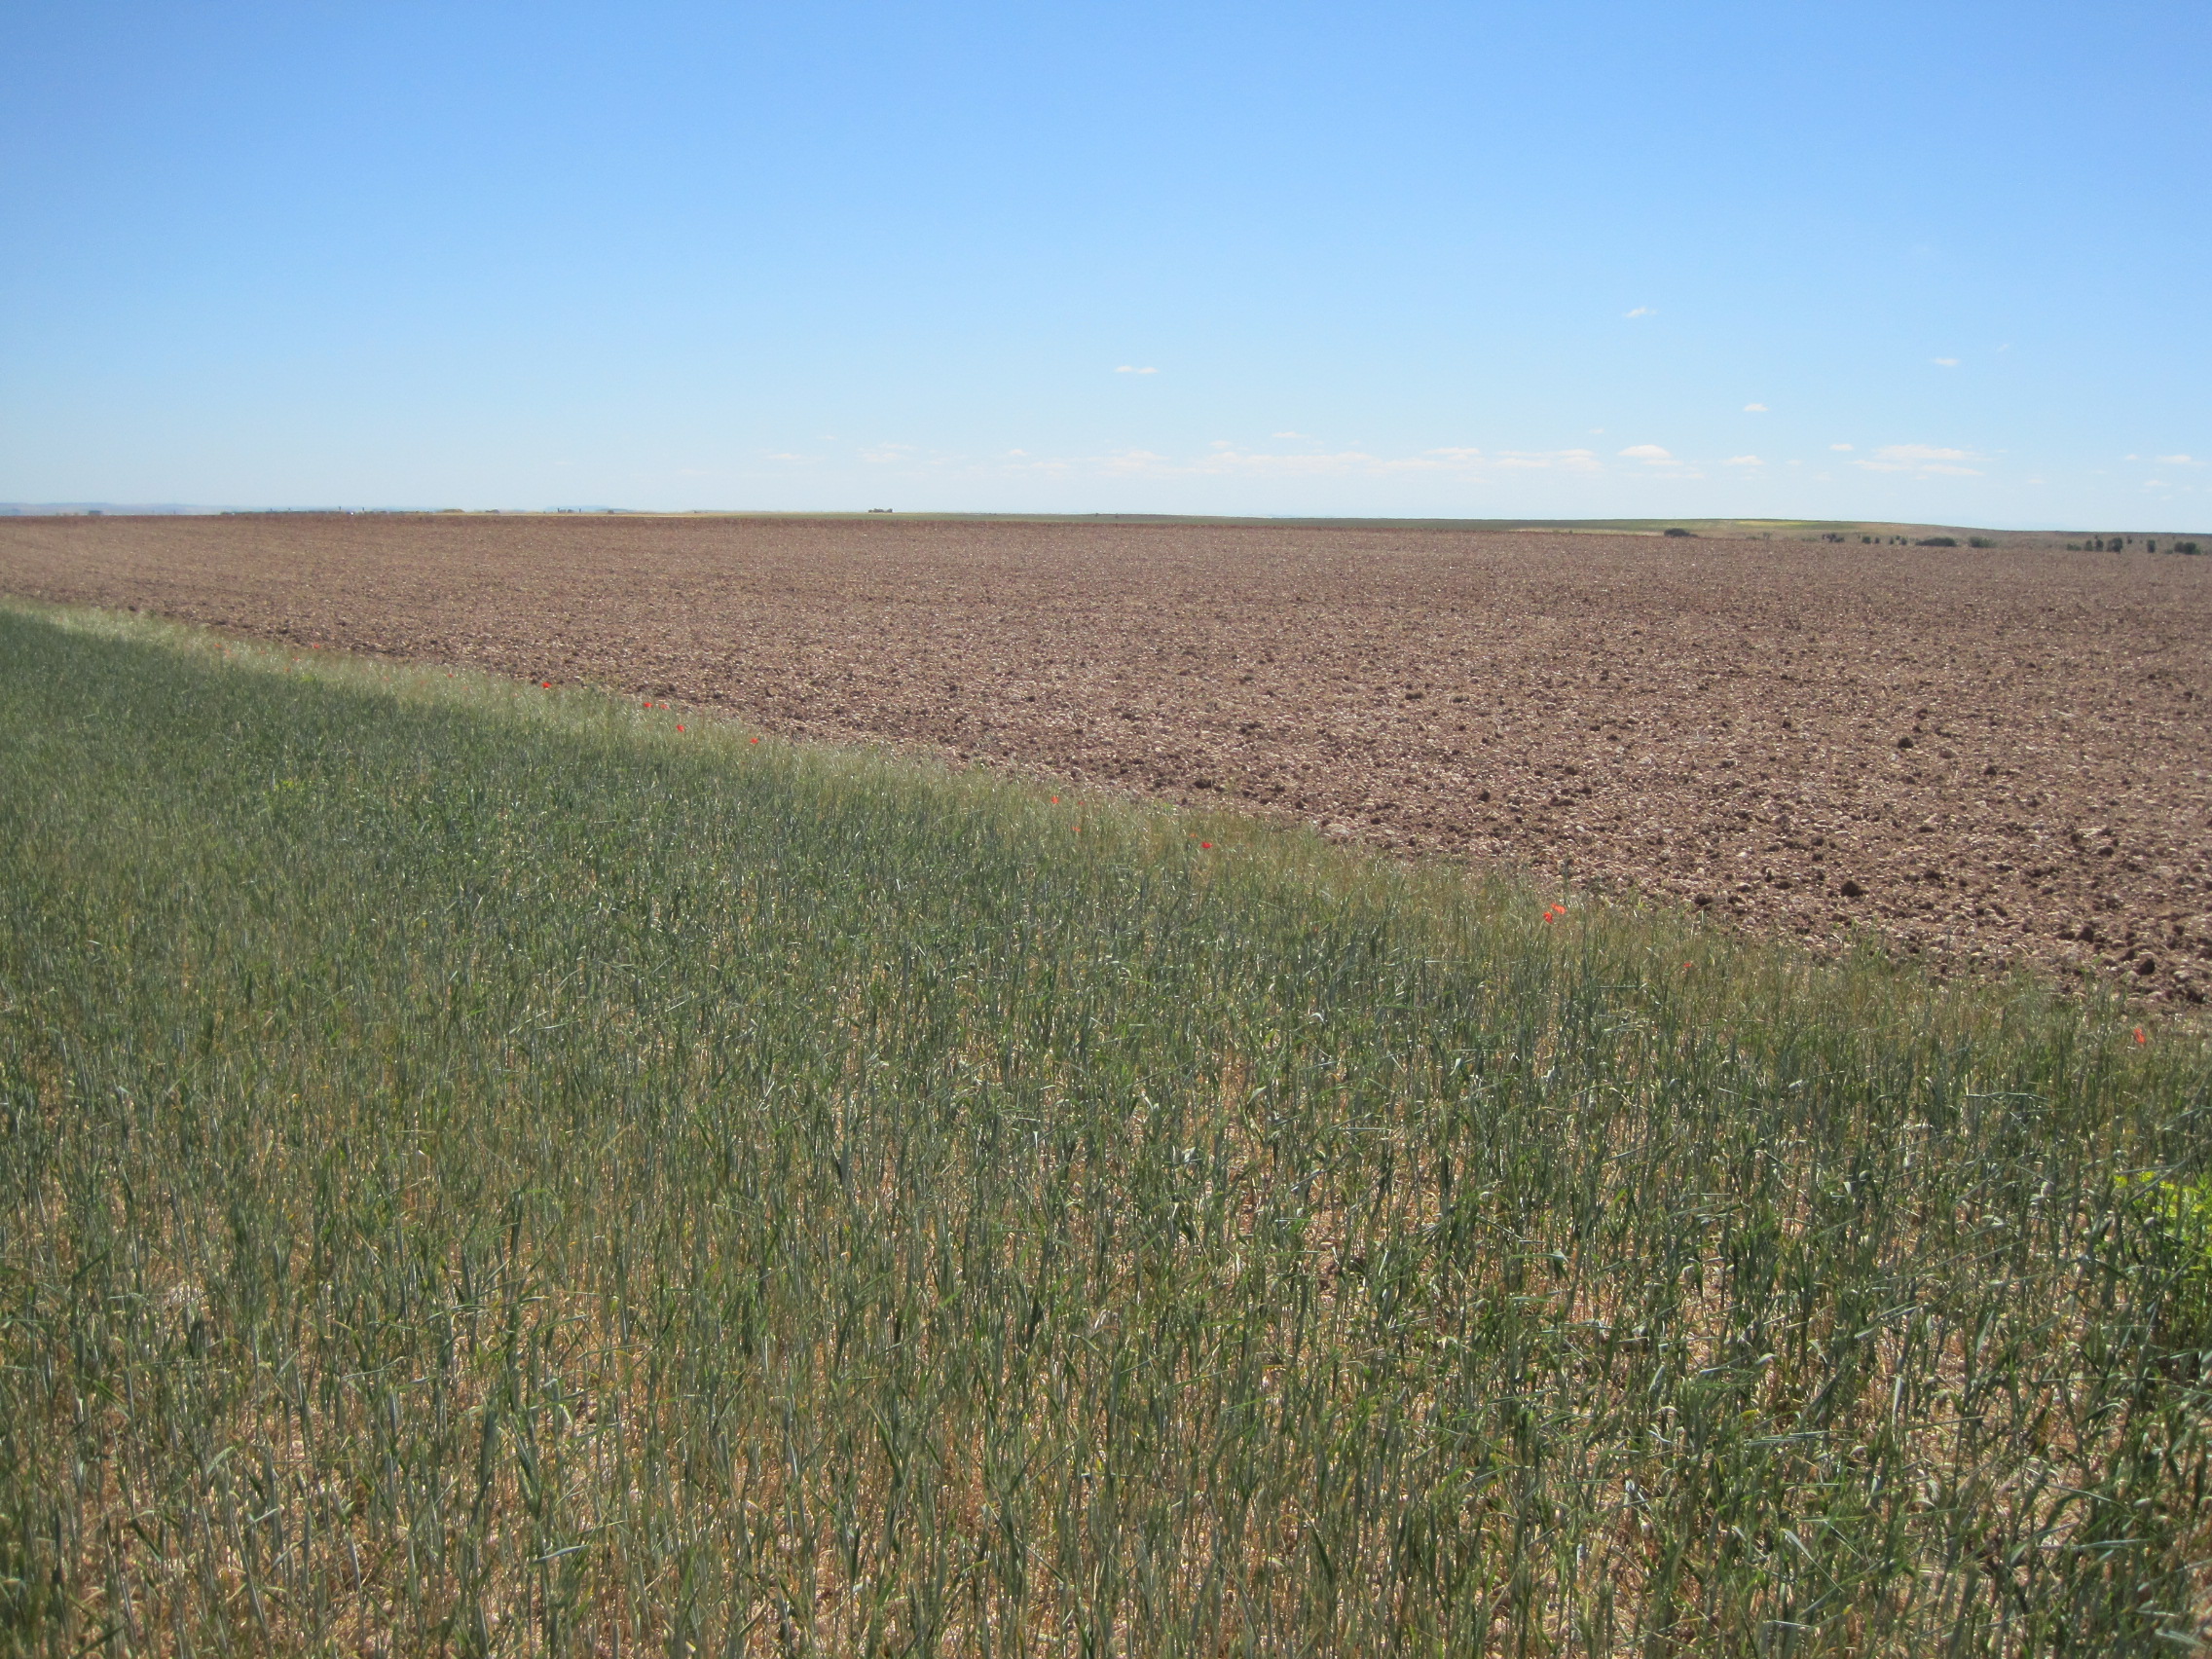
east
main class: Cropland
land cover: Common wheat
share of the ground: > 75 %
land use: Agriculture (excluding fallow land and kitchen gardens)
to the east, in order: Common wheat; Grass margins; Other bare soil
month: May
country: ES
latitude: 41.2432
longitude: -5.3121
